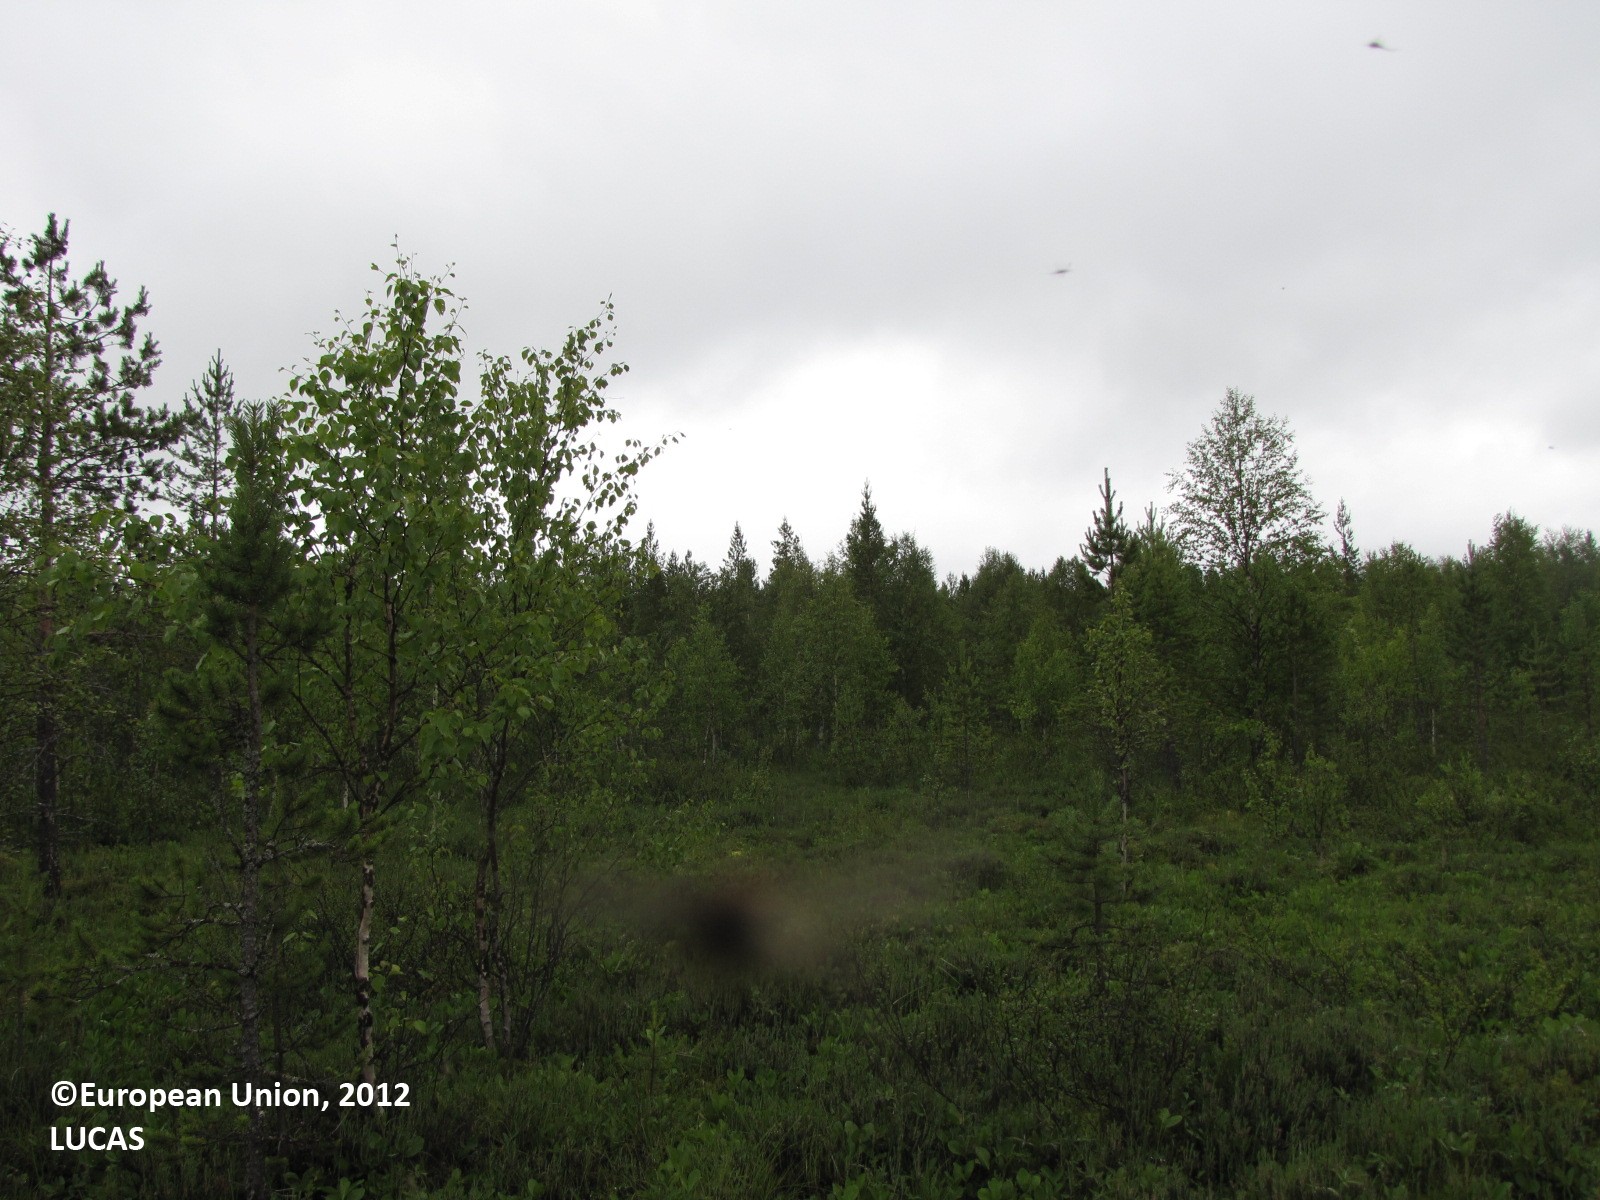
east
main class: Woodland
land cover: Broadleaved woodland
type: boreal forest
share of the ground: 25 - 50 %
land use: Forestry
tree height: > 5 m
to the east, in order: Broadleaved woodland; Pine dominated mixed woodland; Ditches and canals; Pine dominated mixed woodland; Ditches and canals; Spruce dominated mixed woodland; Ditches and canals; Other mixed woodland
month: July
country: FI
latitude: 66.6358
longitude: 24.8041
